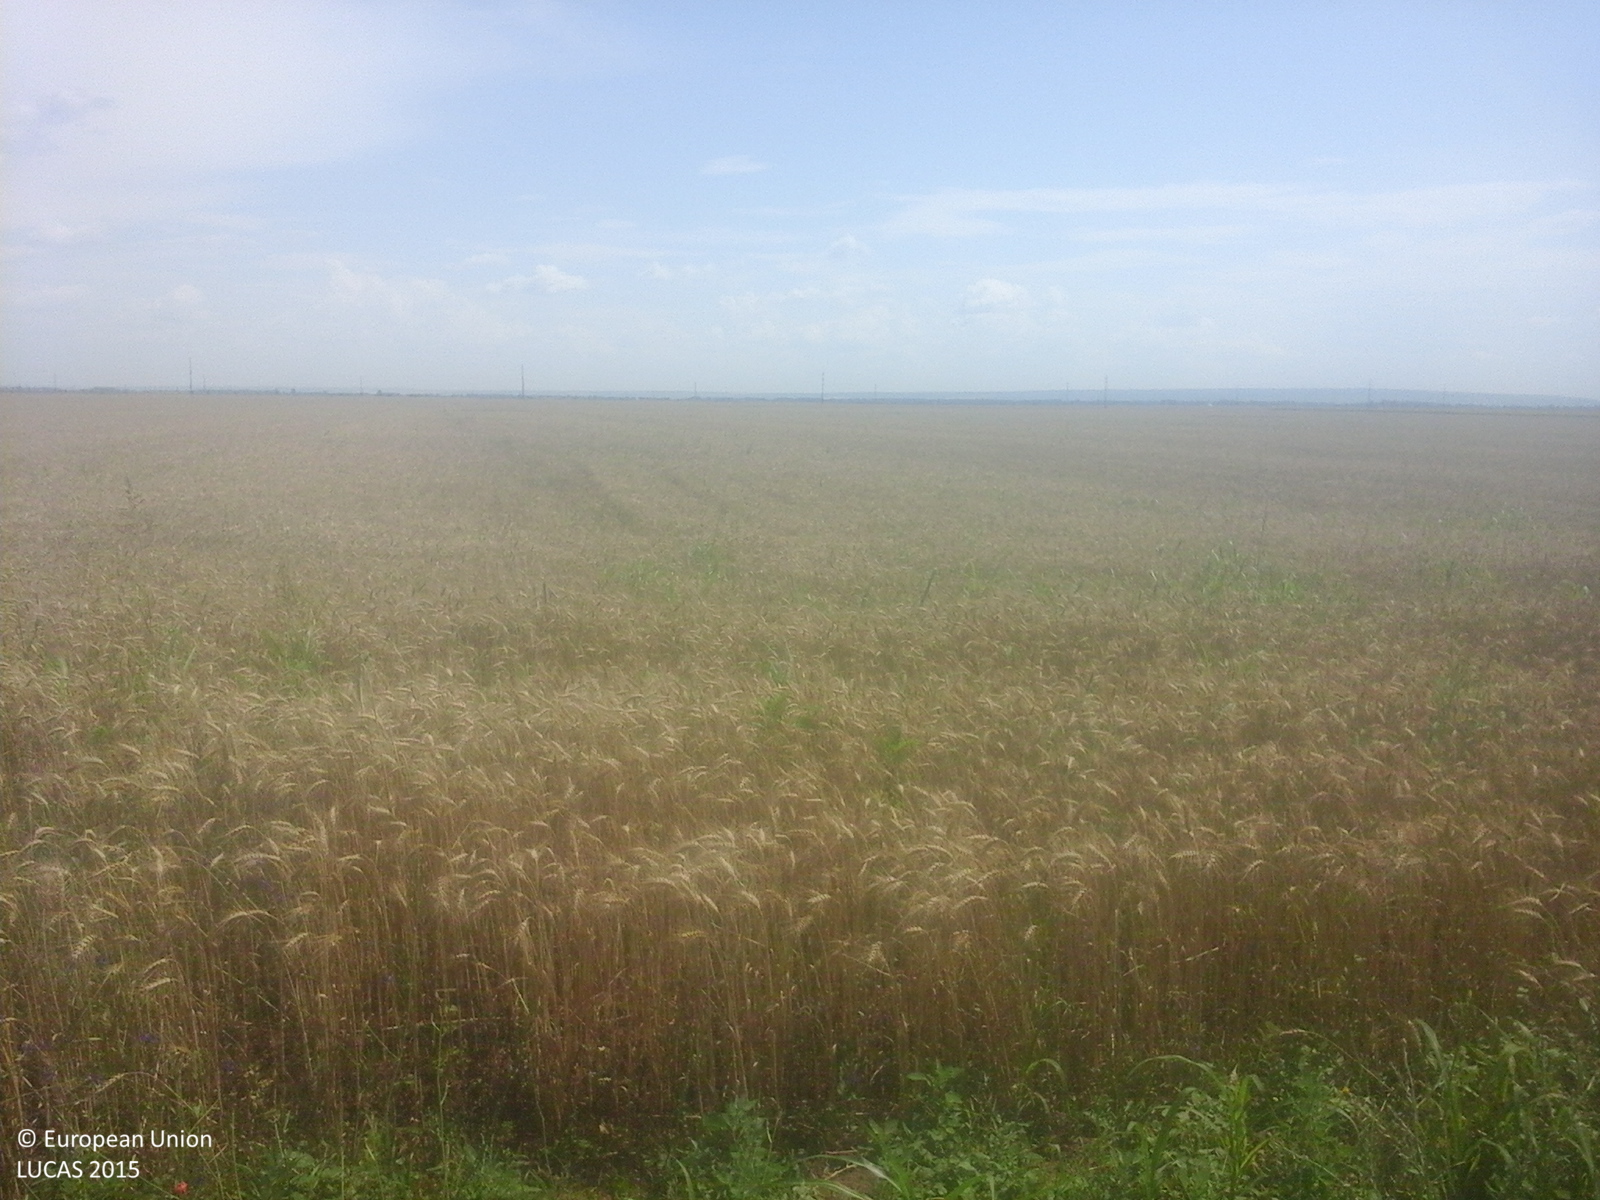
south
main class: Grassland
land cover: Spontaneously vegetated surfaces
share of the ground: > 75 %
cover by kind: herbaceous plants 100 %
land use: Fallow land
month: July
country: RO
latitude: 43.8130
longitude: 24.5488
